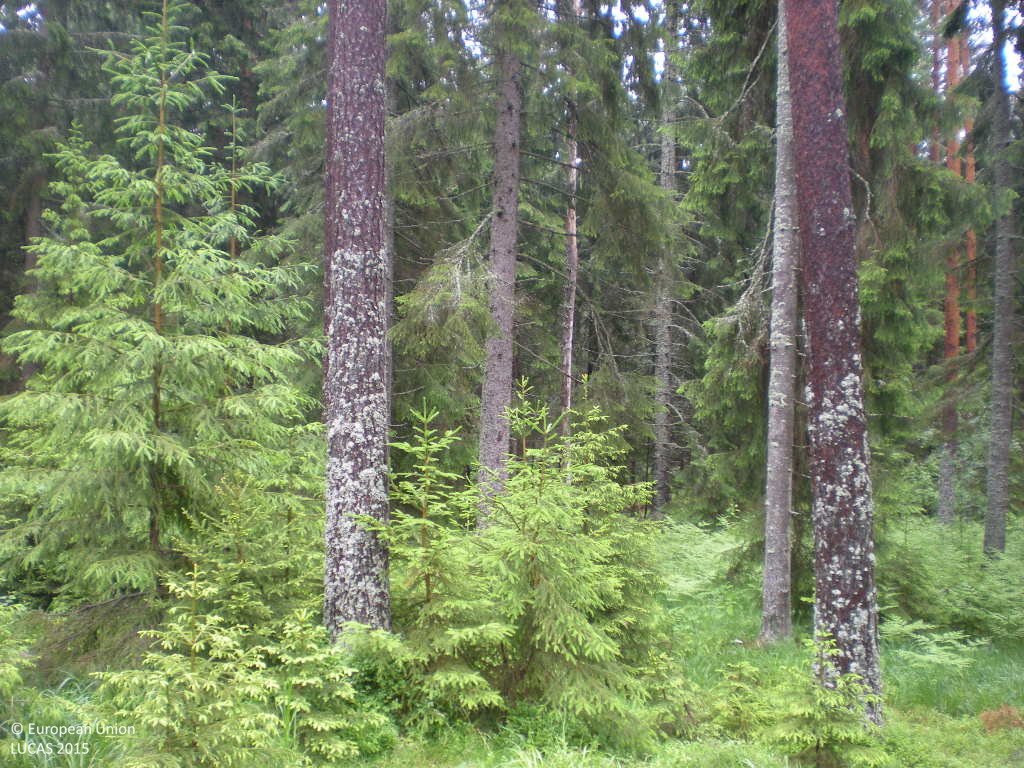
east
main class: Woodland
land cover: Pine dominated coniferous woodland
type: boreal forest
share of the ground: 50 - 75 %
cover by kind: coniferous forest trees 65 %, herbaceous plants 20 %, shrubs 10 %, lichens and mosses 5 %
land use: Forestry
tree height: > 5 m
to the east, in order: Pine dominated coniferous woodland; Other coniferous woodland; Spruce dominated coniferous woodland; Ditches and canals; Spruce dominated coniferous woodland; Spruce dominated mixed woodland; Other coniferous woodland; Pine dominated coniferous woodland; Other coniferous woodland
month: June
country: SE
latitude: 60.3407
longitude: 17.8738
